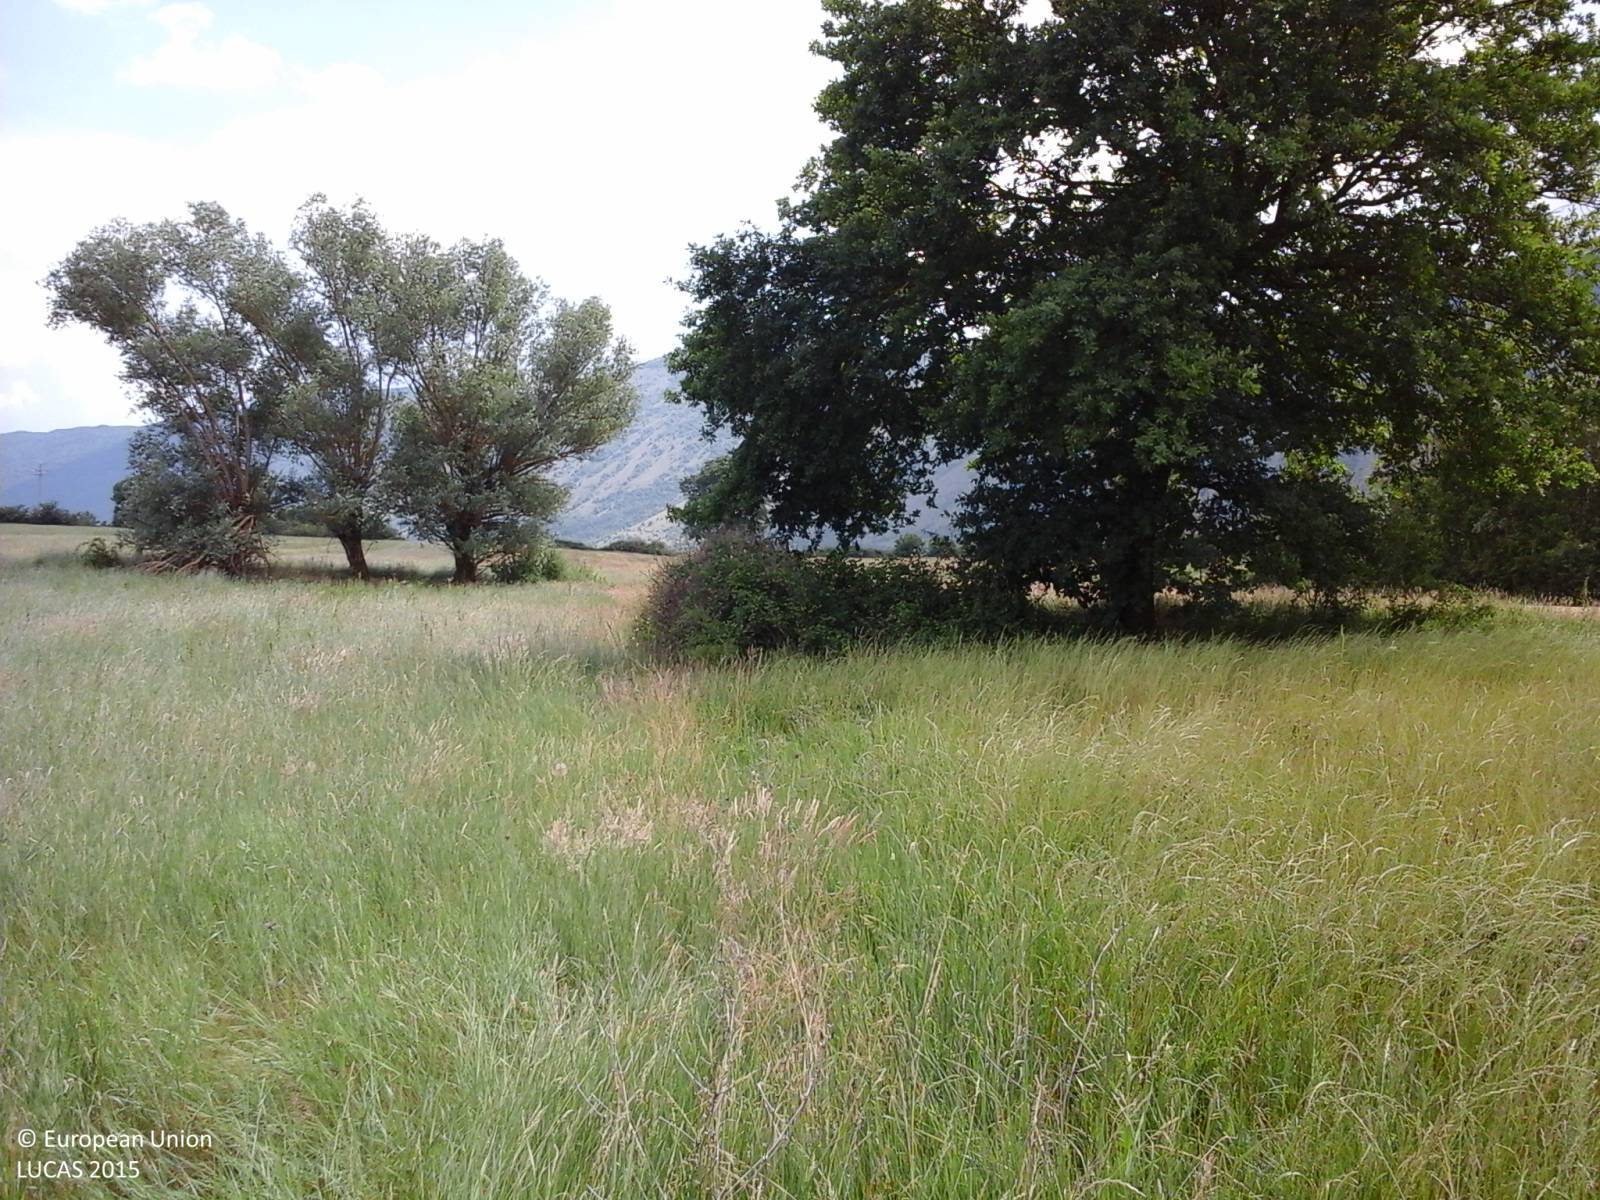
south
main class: Cropland
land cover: Mixed cereals for fodder
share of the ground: > 75 %
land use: Agriculture (excluding fallow land and kitchen gardens)
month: June
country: IT
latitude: 42.0387
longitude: 13.3346
